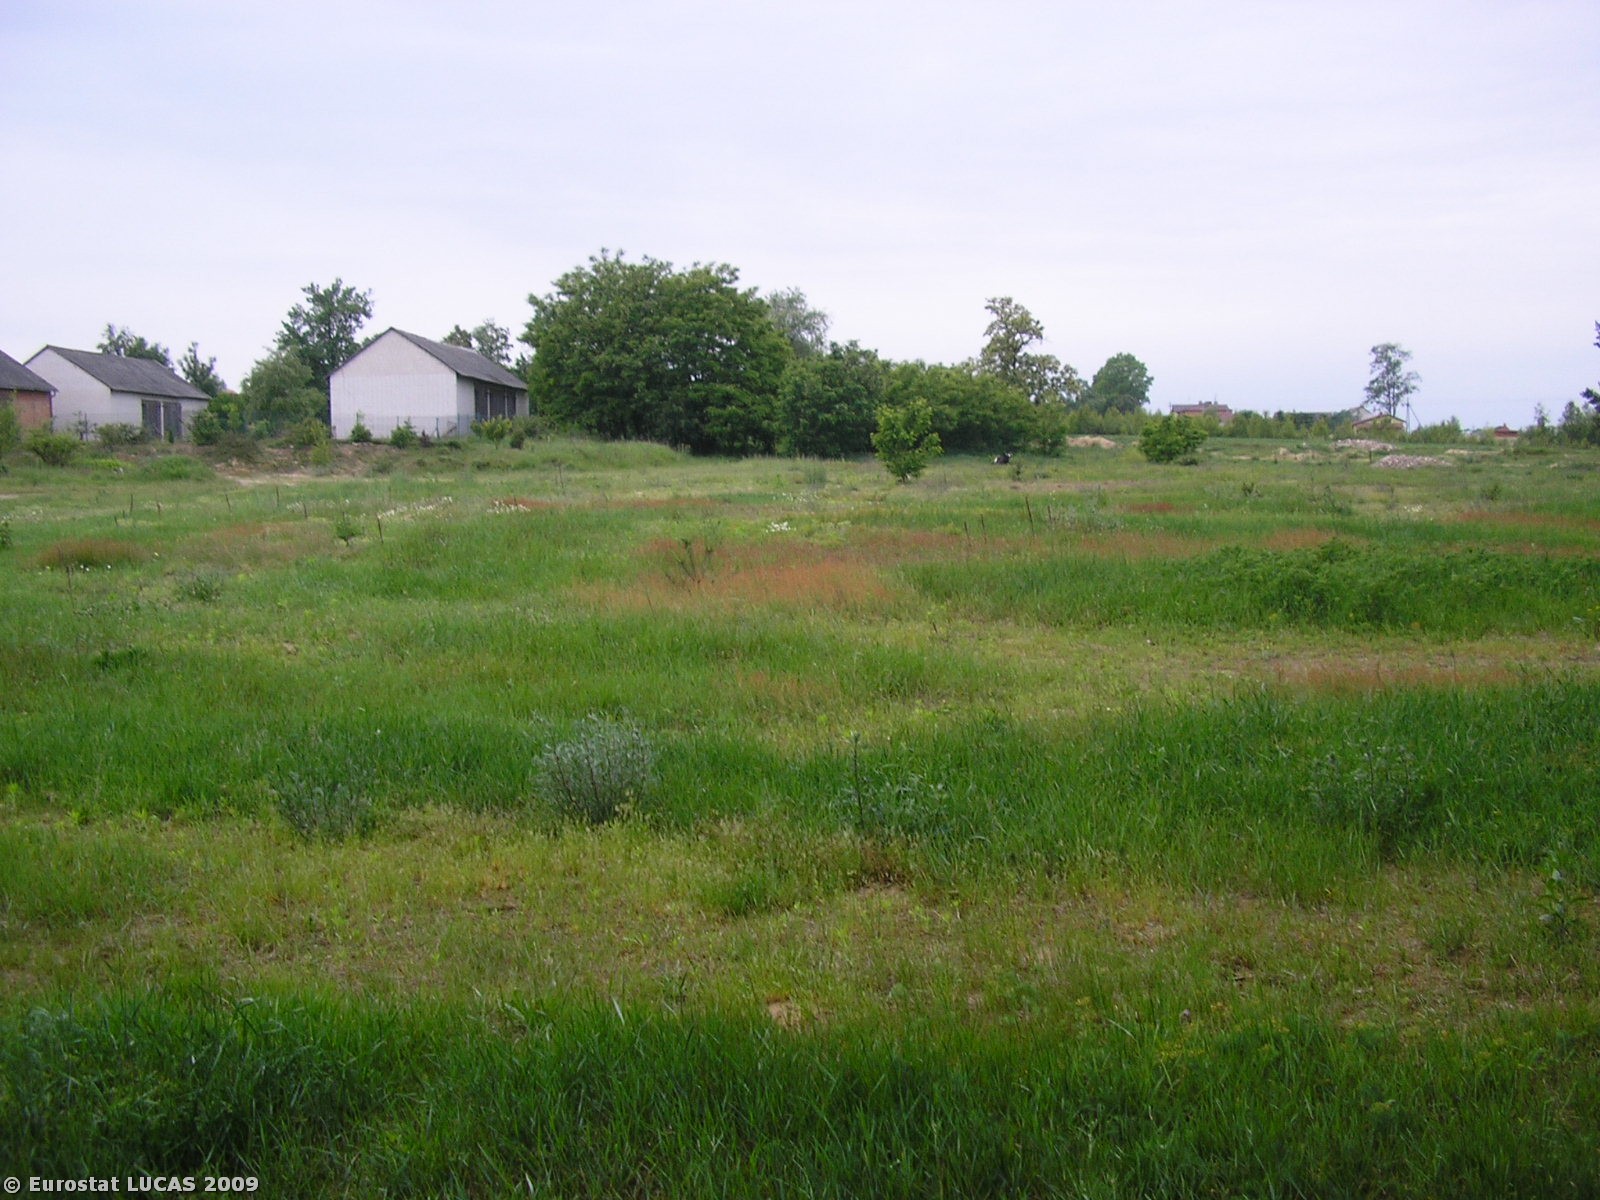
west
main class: Woodland
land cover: Coniferous woodland
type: hemiboreal forest and nemoral coniferous forest and mixed broadleaved-coniferous forest
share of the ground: 50 - 75 %
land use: Forestry
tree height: > 5 m
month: June
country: PL
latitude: 51.4948
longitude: 18.9679
